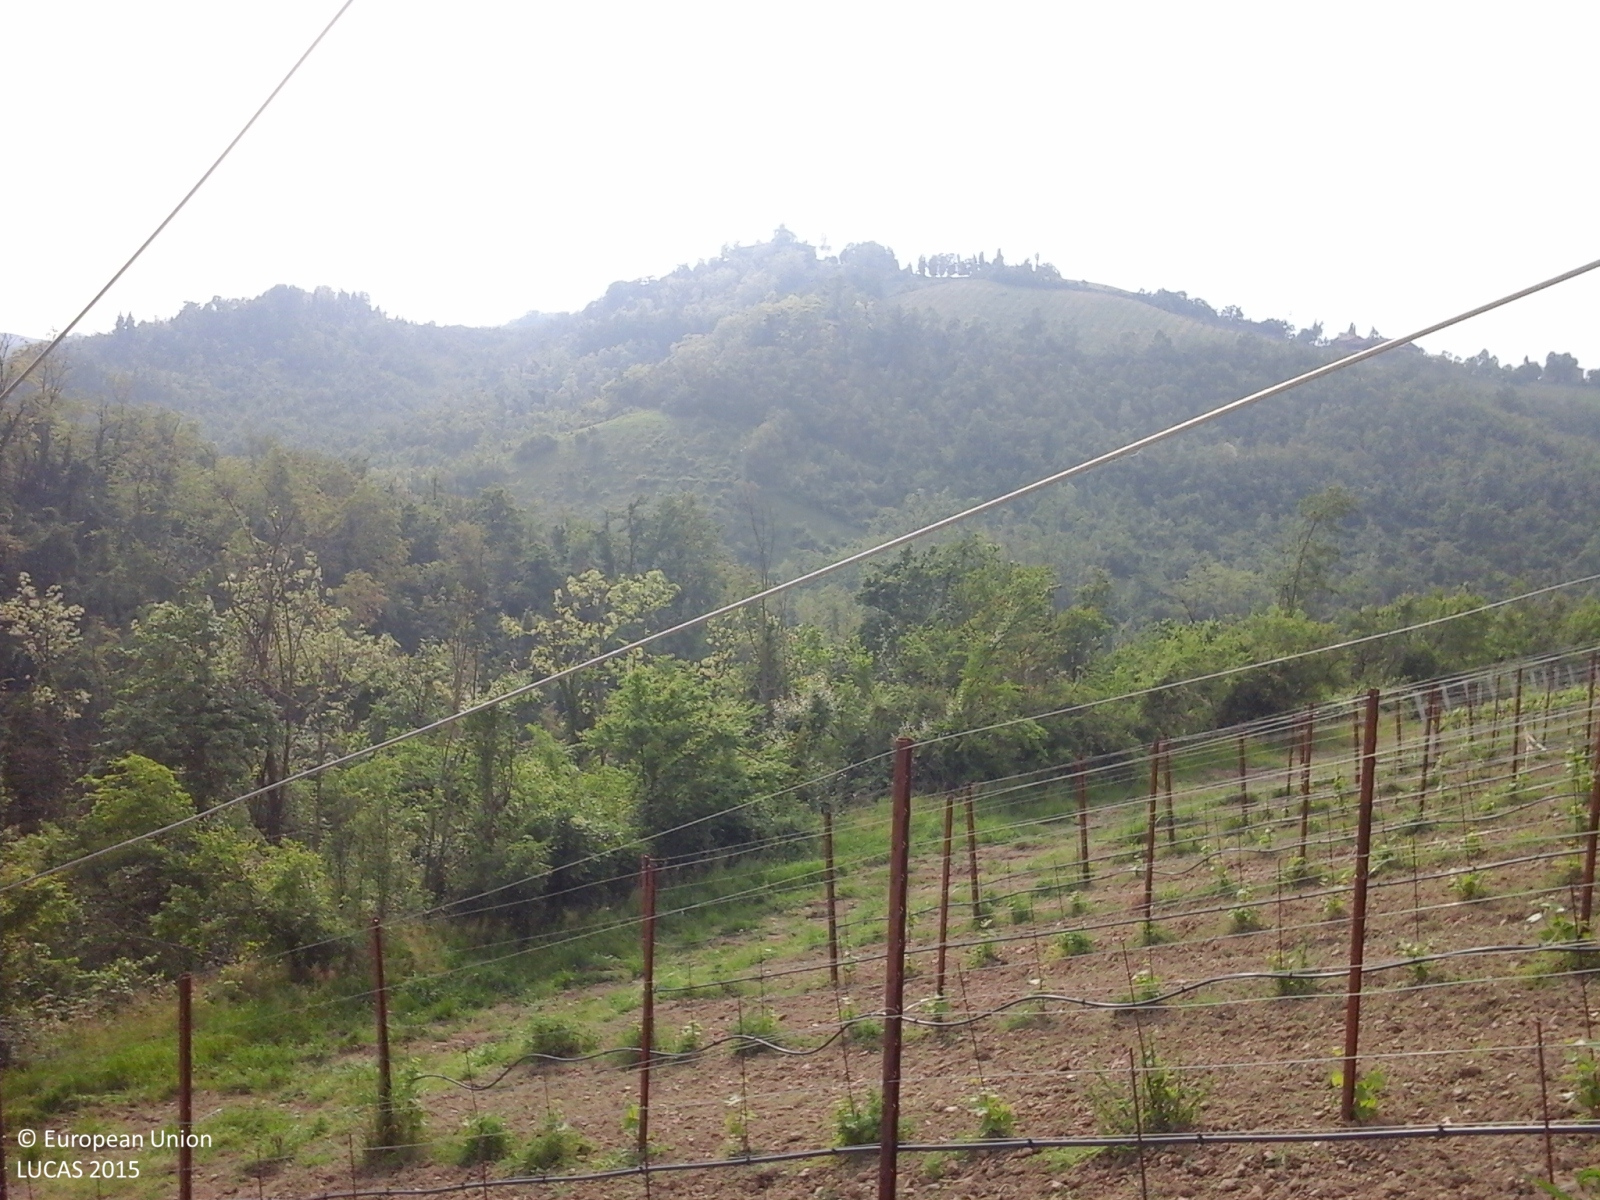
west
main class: Cropland
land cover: Vineyards
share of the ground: < 10 %
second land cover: Other bare soil
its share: > 75 %
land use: Agriculture (excluding fallow land and kitchen gardens)
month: May
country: IT
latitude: 44.4713
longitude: 11.0662
